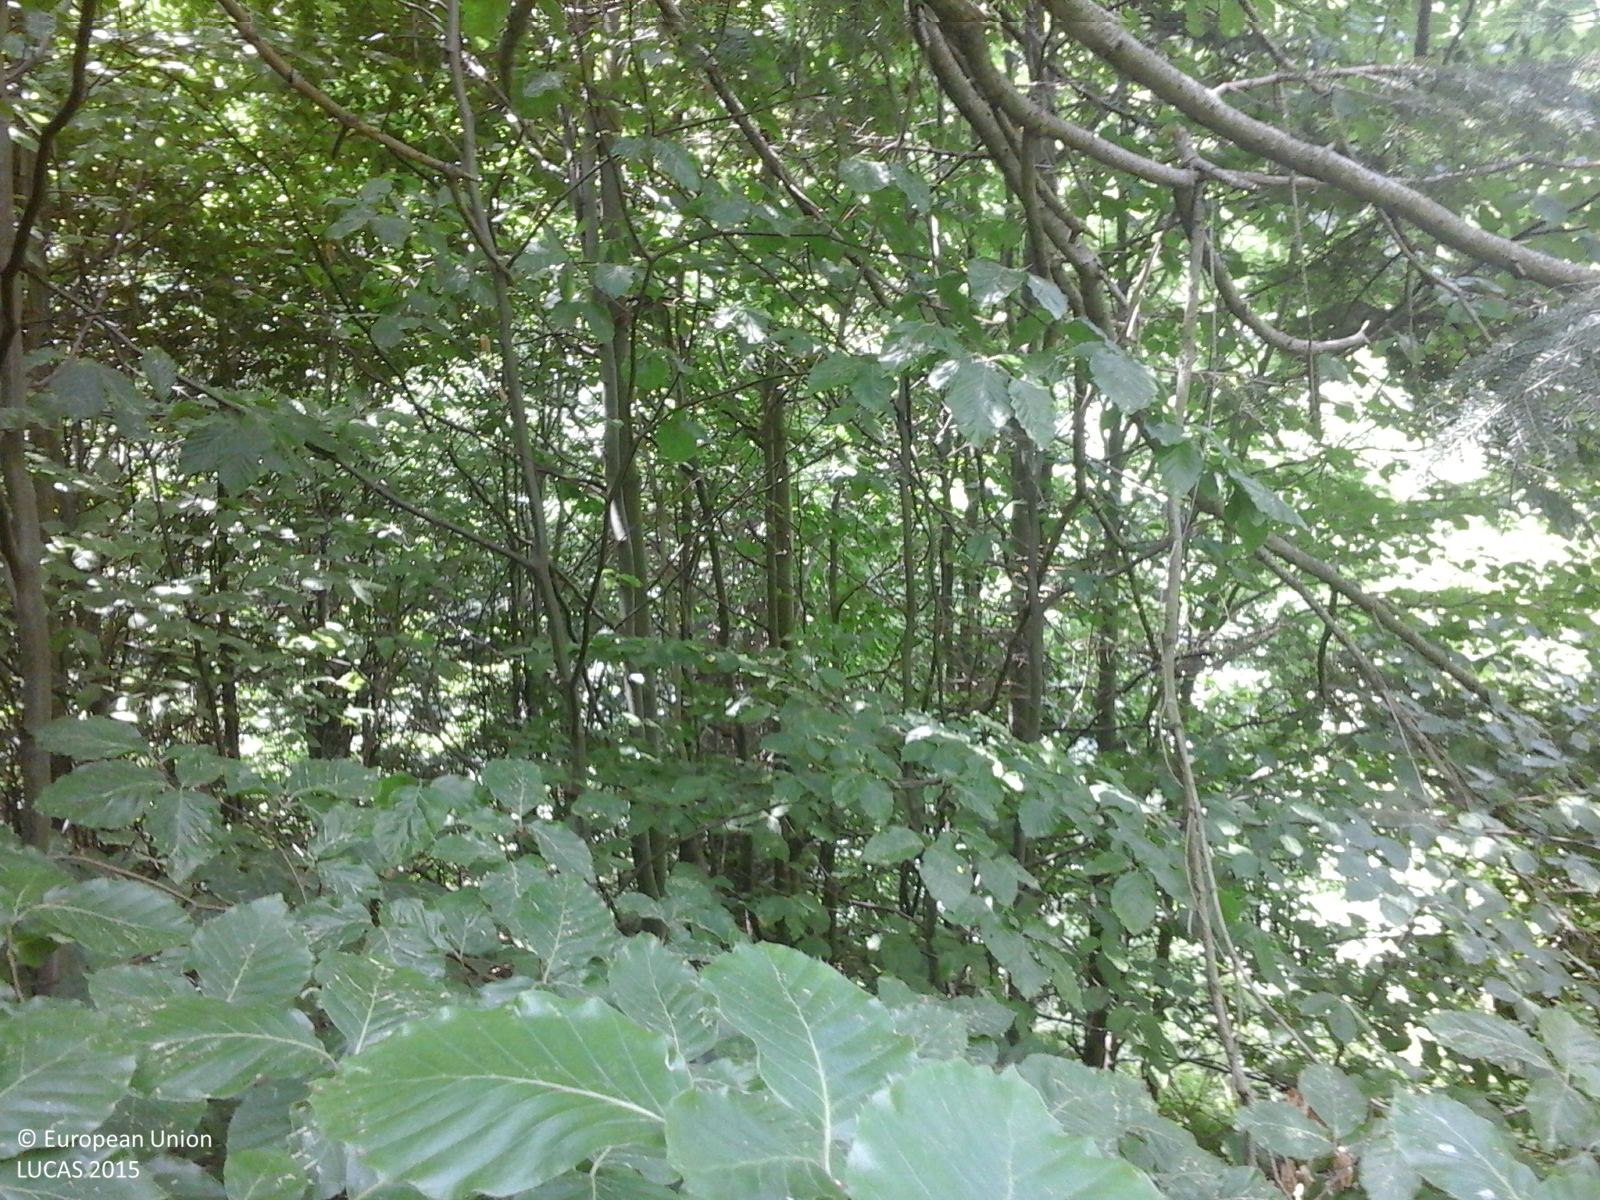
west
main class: Woodland
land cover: Other mixed woodland
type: beech forest
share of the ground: > 75 %
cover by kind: broadleaved forest trees 75 %, coniferous forest trees 25 %
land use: Forestry
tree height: > 5 m
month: June
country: RO
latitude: 47.6906
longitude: 25.7246
